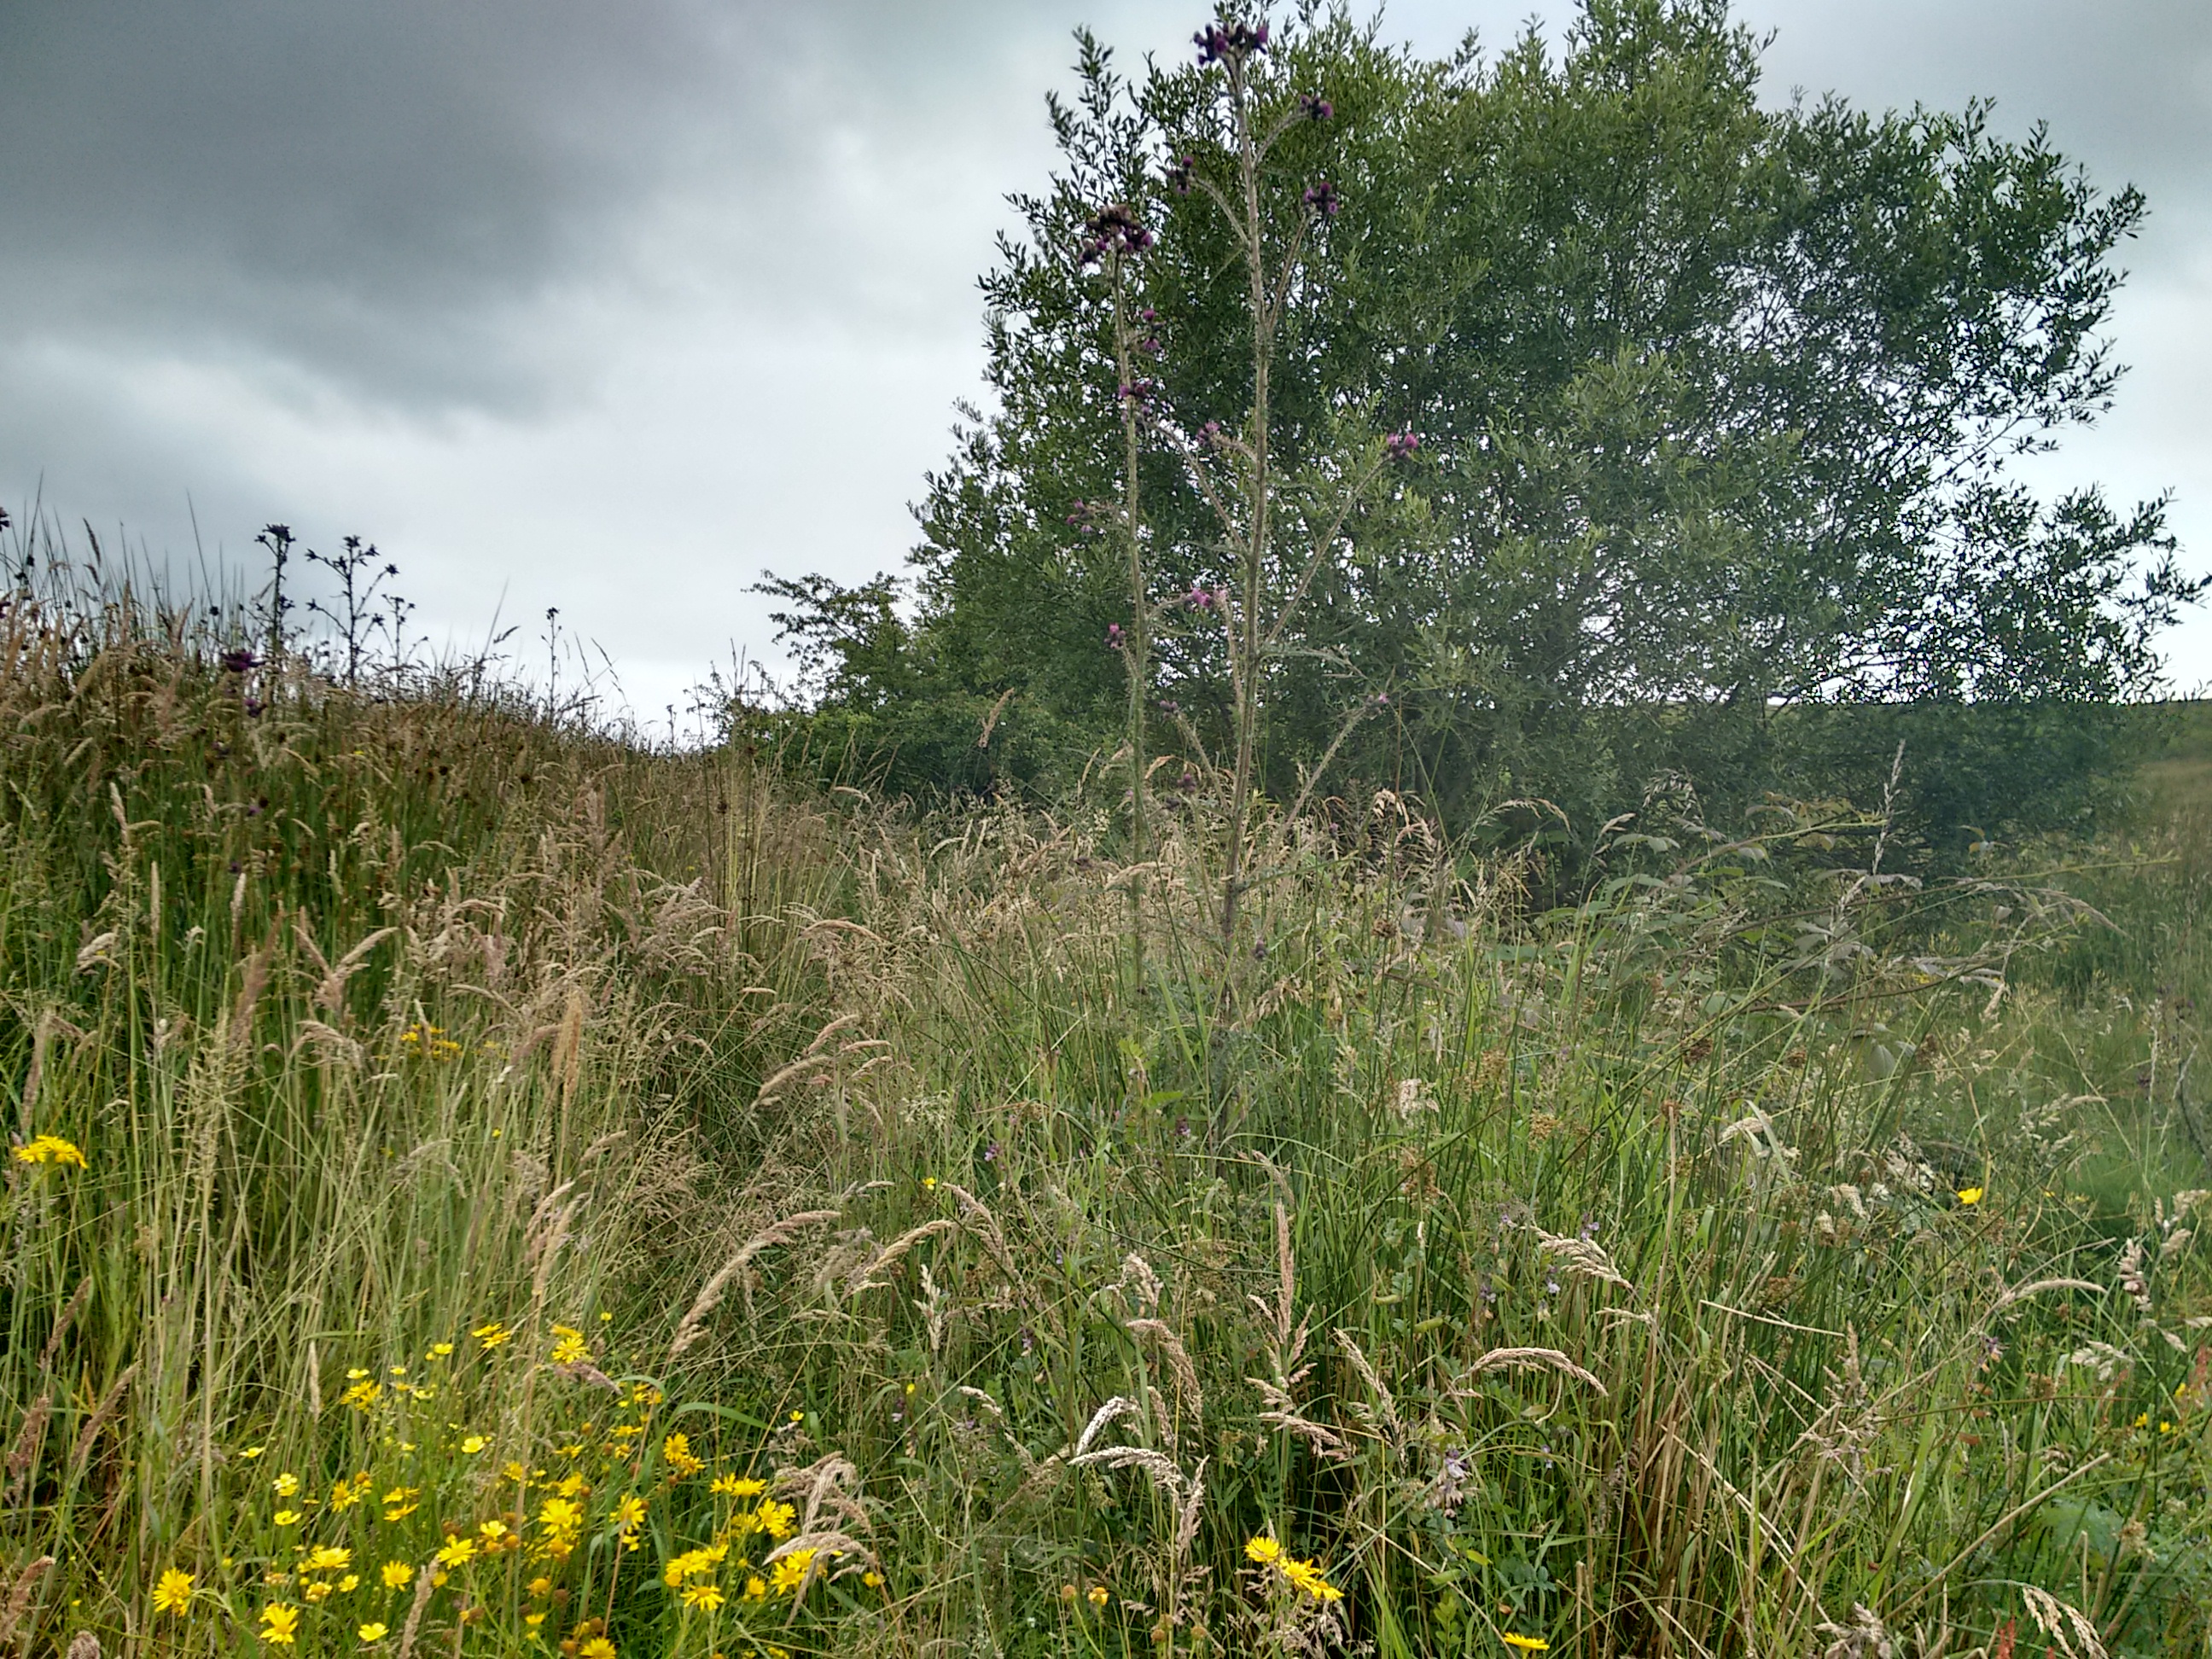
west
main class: Grassland
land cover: Grassland without tree/shrub cover
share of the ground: > 75 %
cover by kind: herbaceous plants 100 %
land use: Agriculture (excluding fallow land and kitchen gardens)
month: July
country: GB
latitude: 54.4909
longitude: -7.1094
